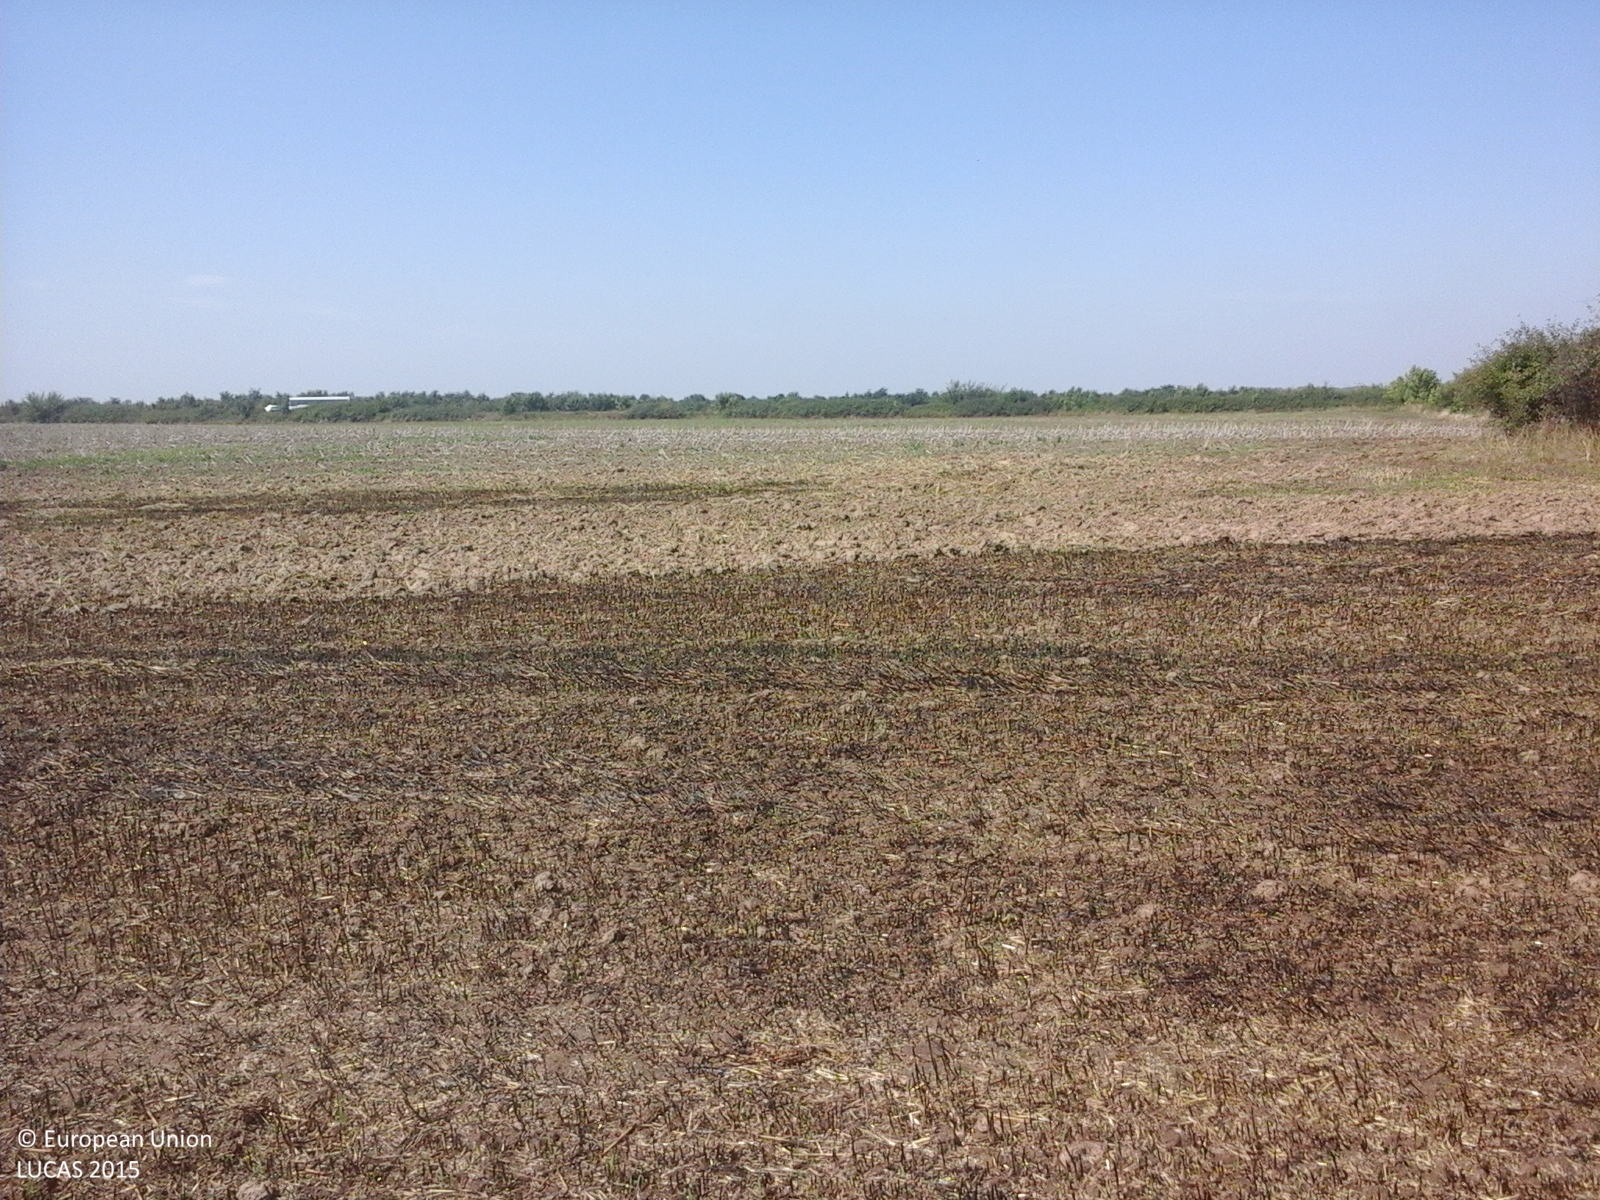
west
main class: Cropland
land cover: Common wheat
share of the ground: 25 - 50 %
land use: Agriculture (excluding fallow land and kitchen gardens)
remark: Burnt area
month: August
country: RO
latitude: 45.6157
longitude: 21.1991
